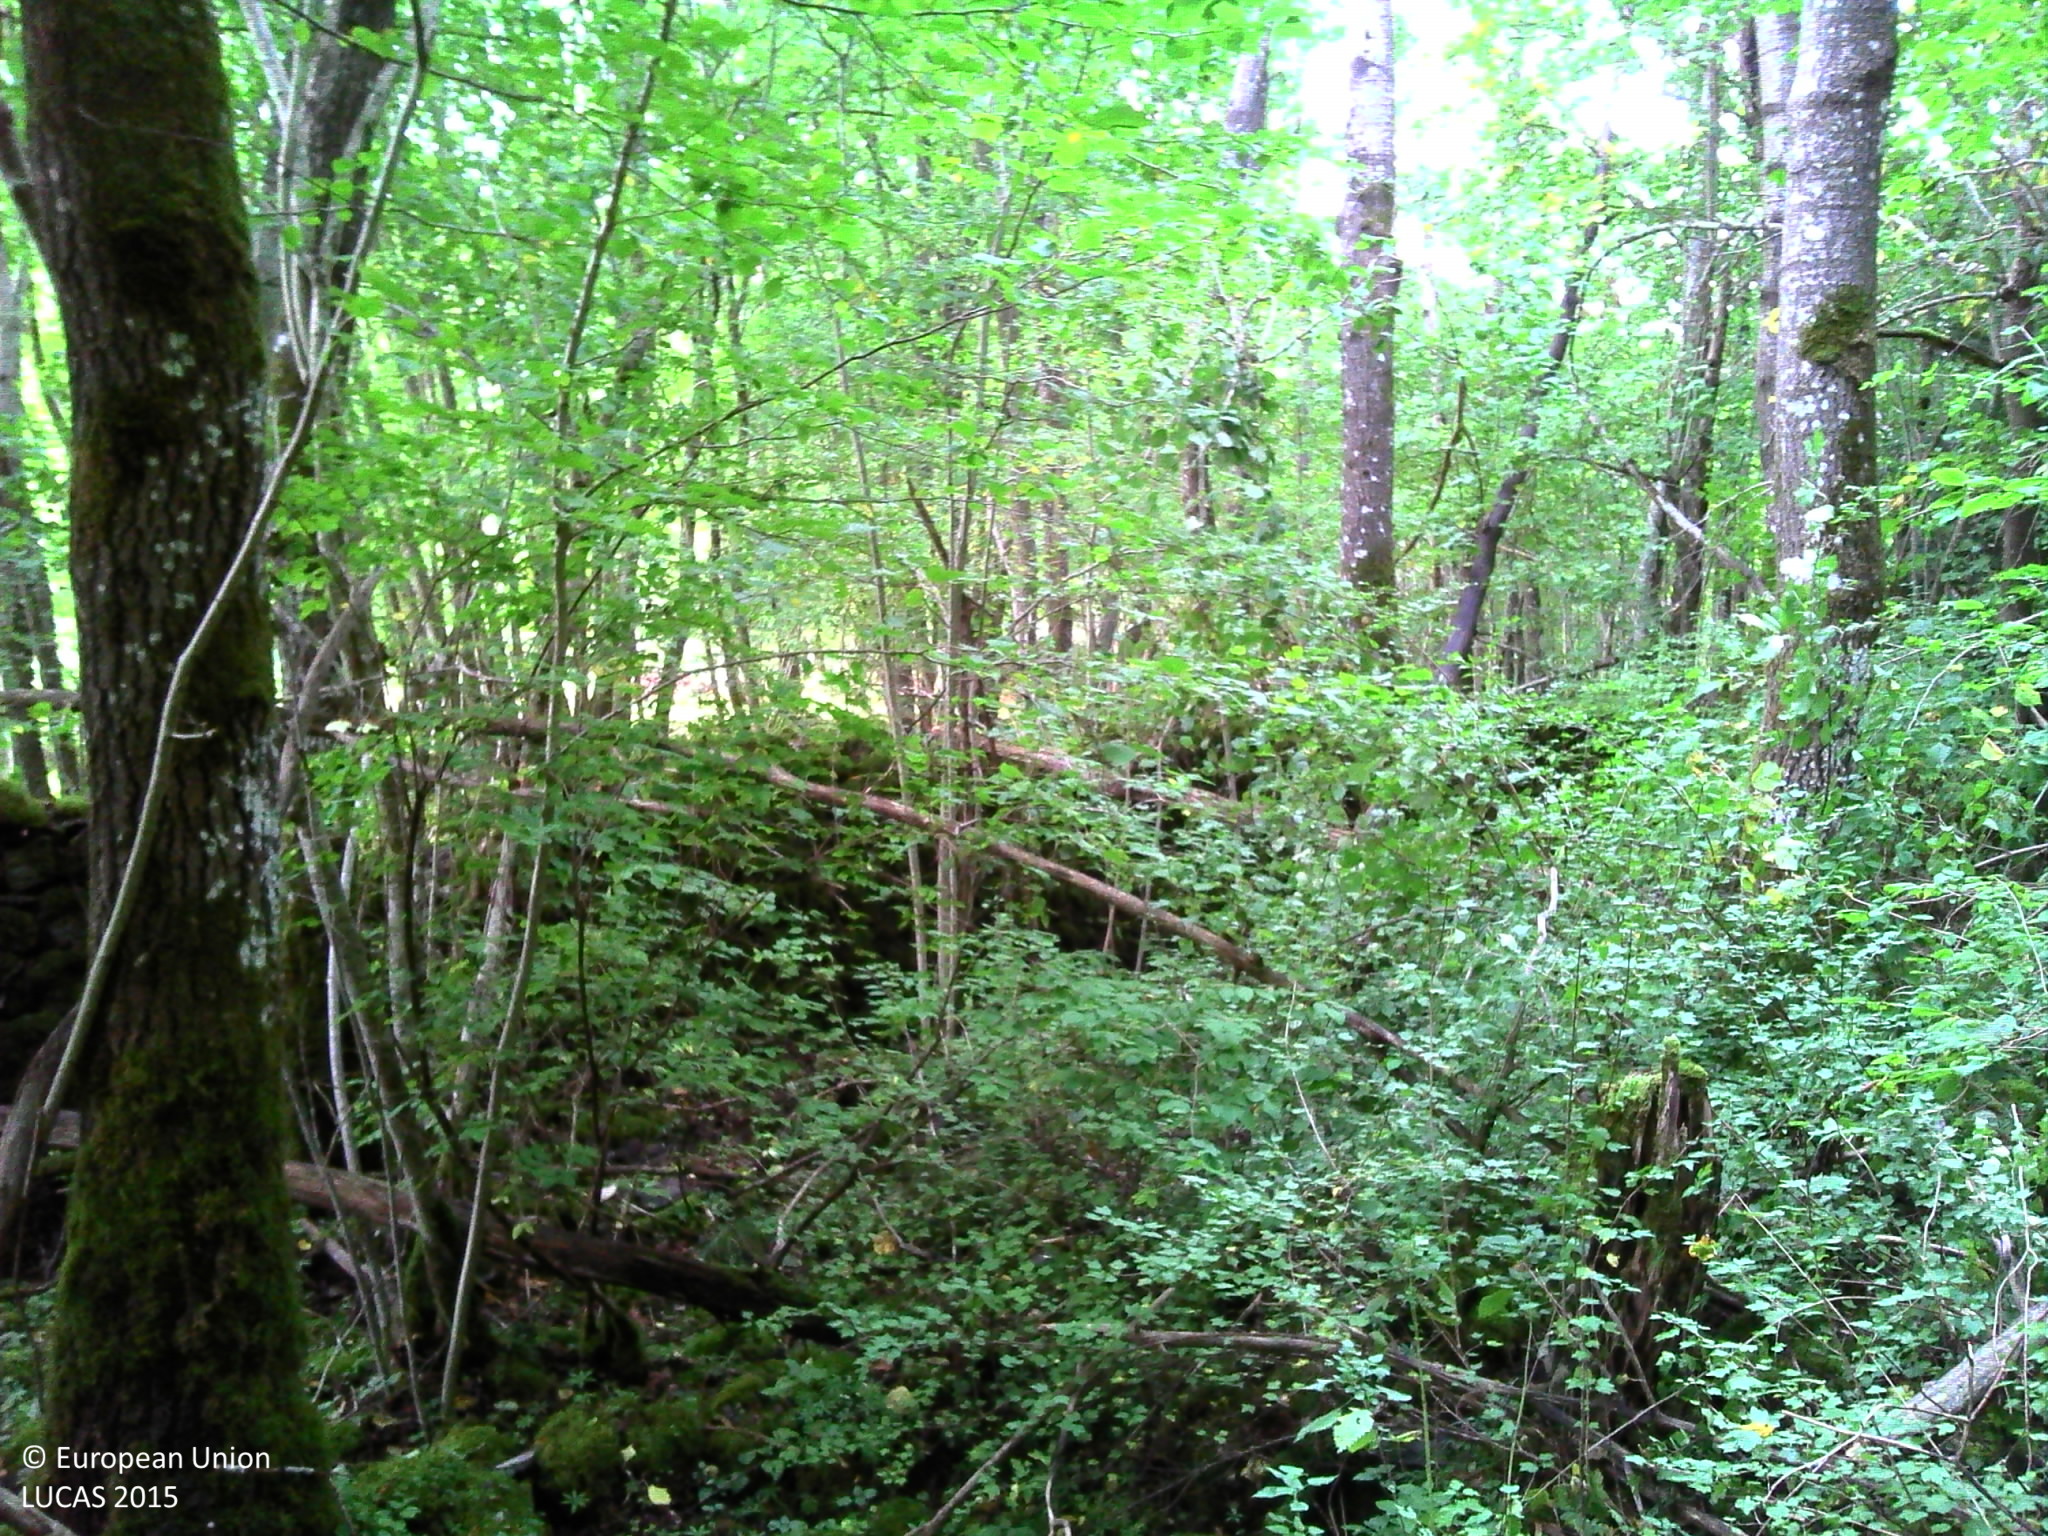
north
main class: Woodland
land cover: Broadleaved woodland
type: mesophytic deciduous forest
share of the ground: > 75 %
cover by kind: broadleaved forest trees 70 %, herbaceous plants 30 %
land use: Forestry
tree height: > 5 m
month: September
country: FR
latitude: 45.8408
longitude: 2.8527
